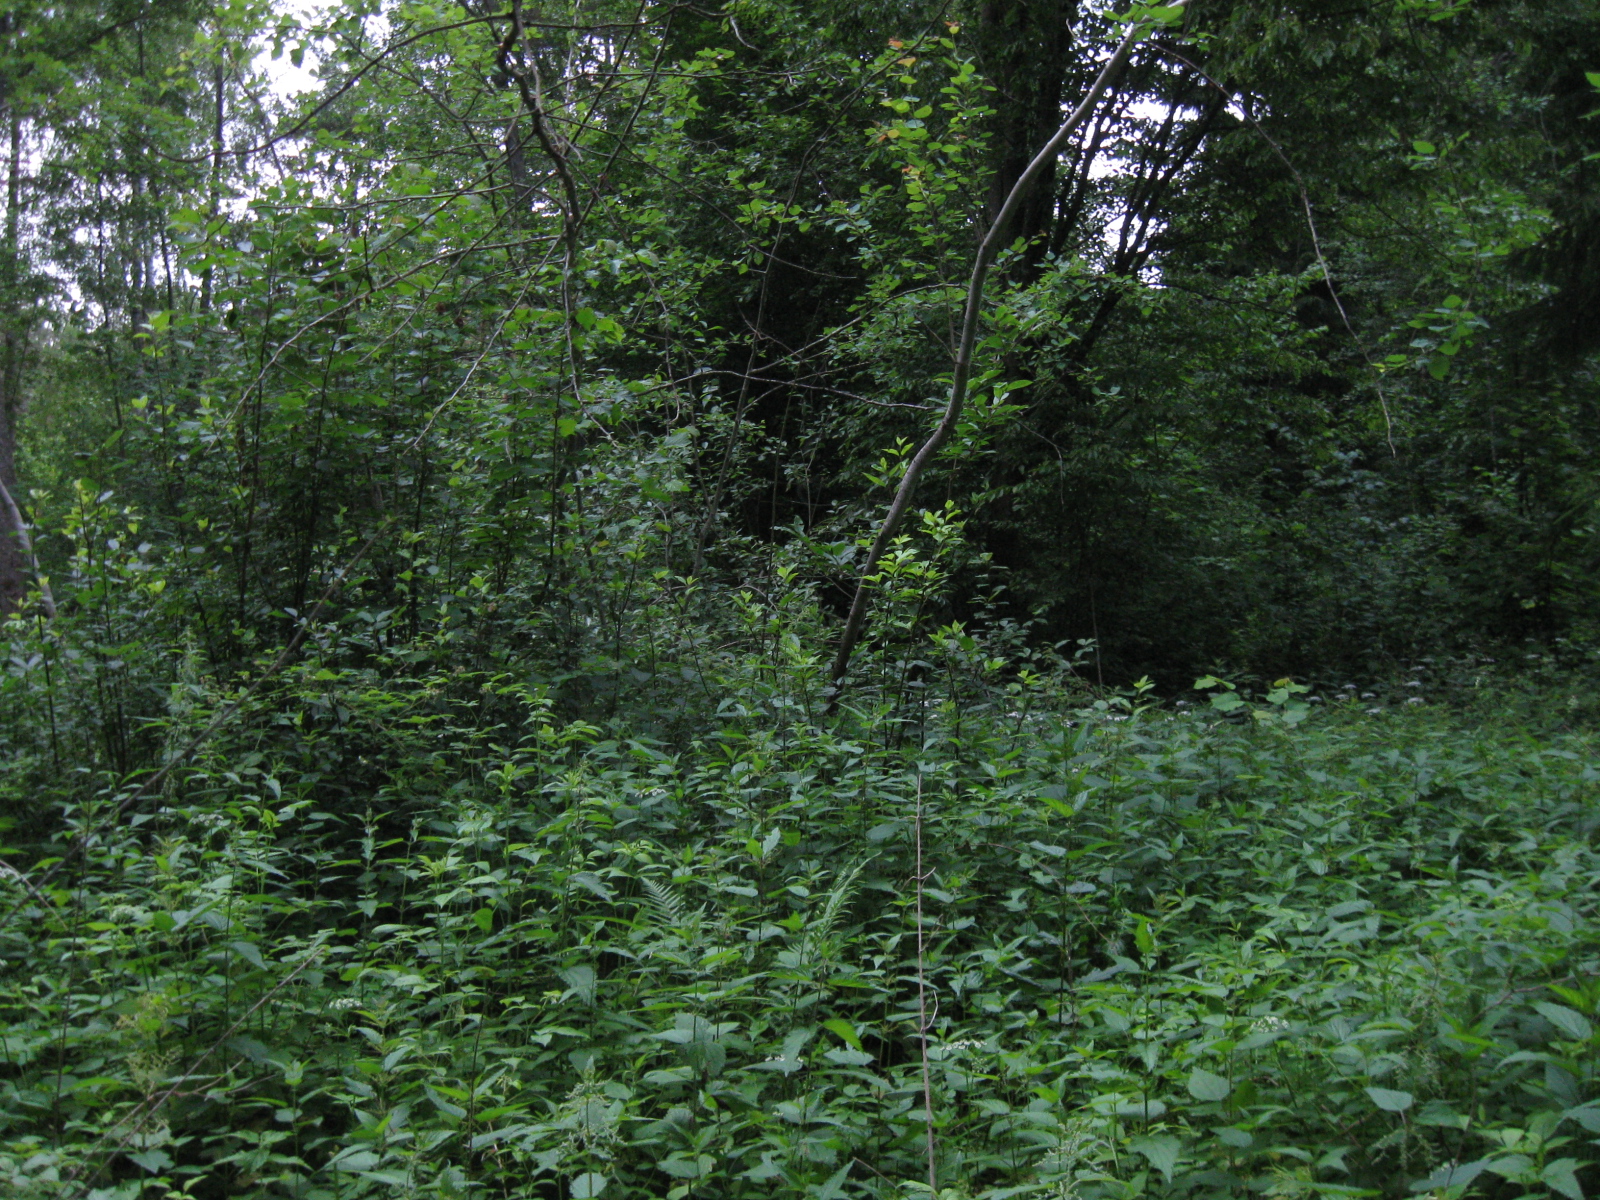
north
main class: Woodland
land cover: Broadleaved woodland
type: non-riverine alder, birch or aspen forest
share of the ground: > 75 %
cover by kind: broadleaved forest trees 80 %, coniferous forest trees 10 %, herbaceous plants 10 %
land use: Forestry
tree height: > 5 m
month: June
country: LT
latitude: 54.6656
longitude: 24.4744
